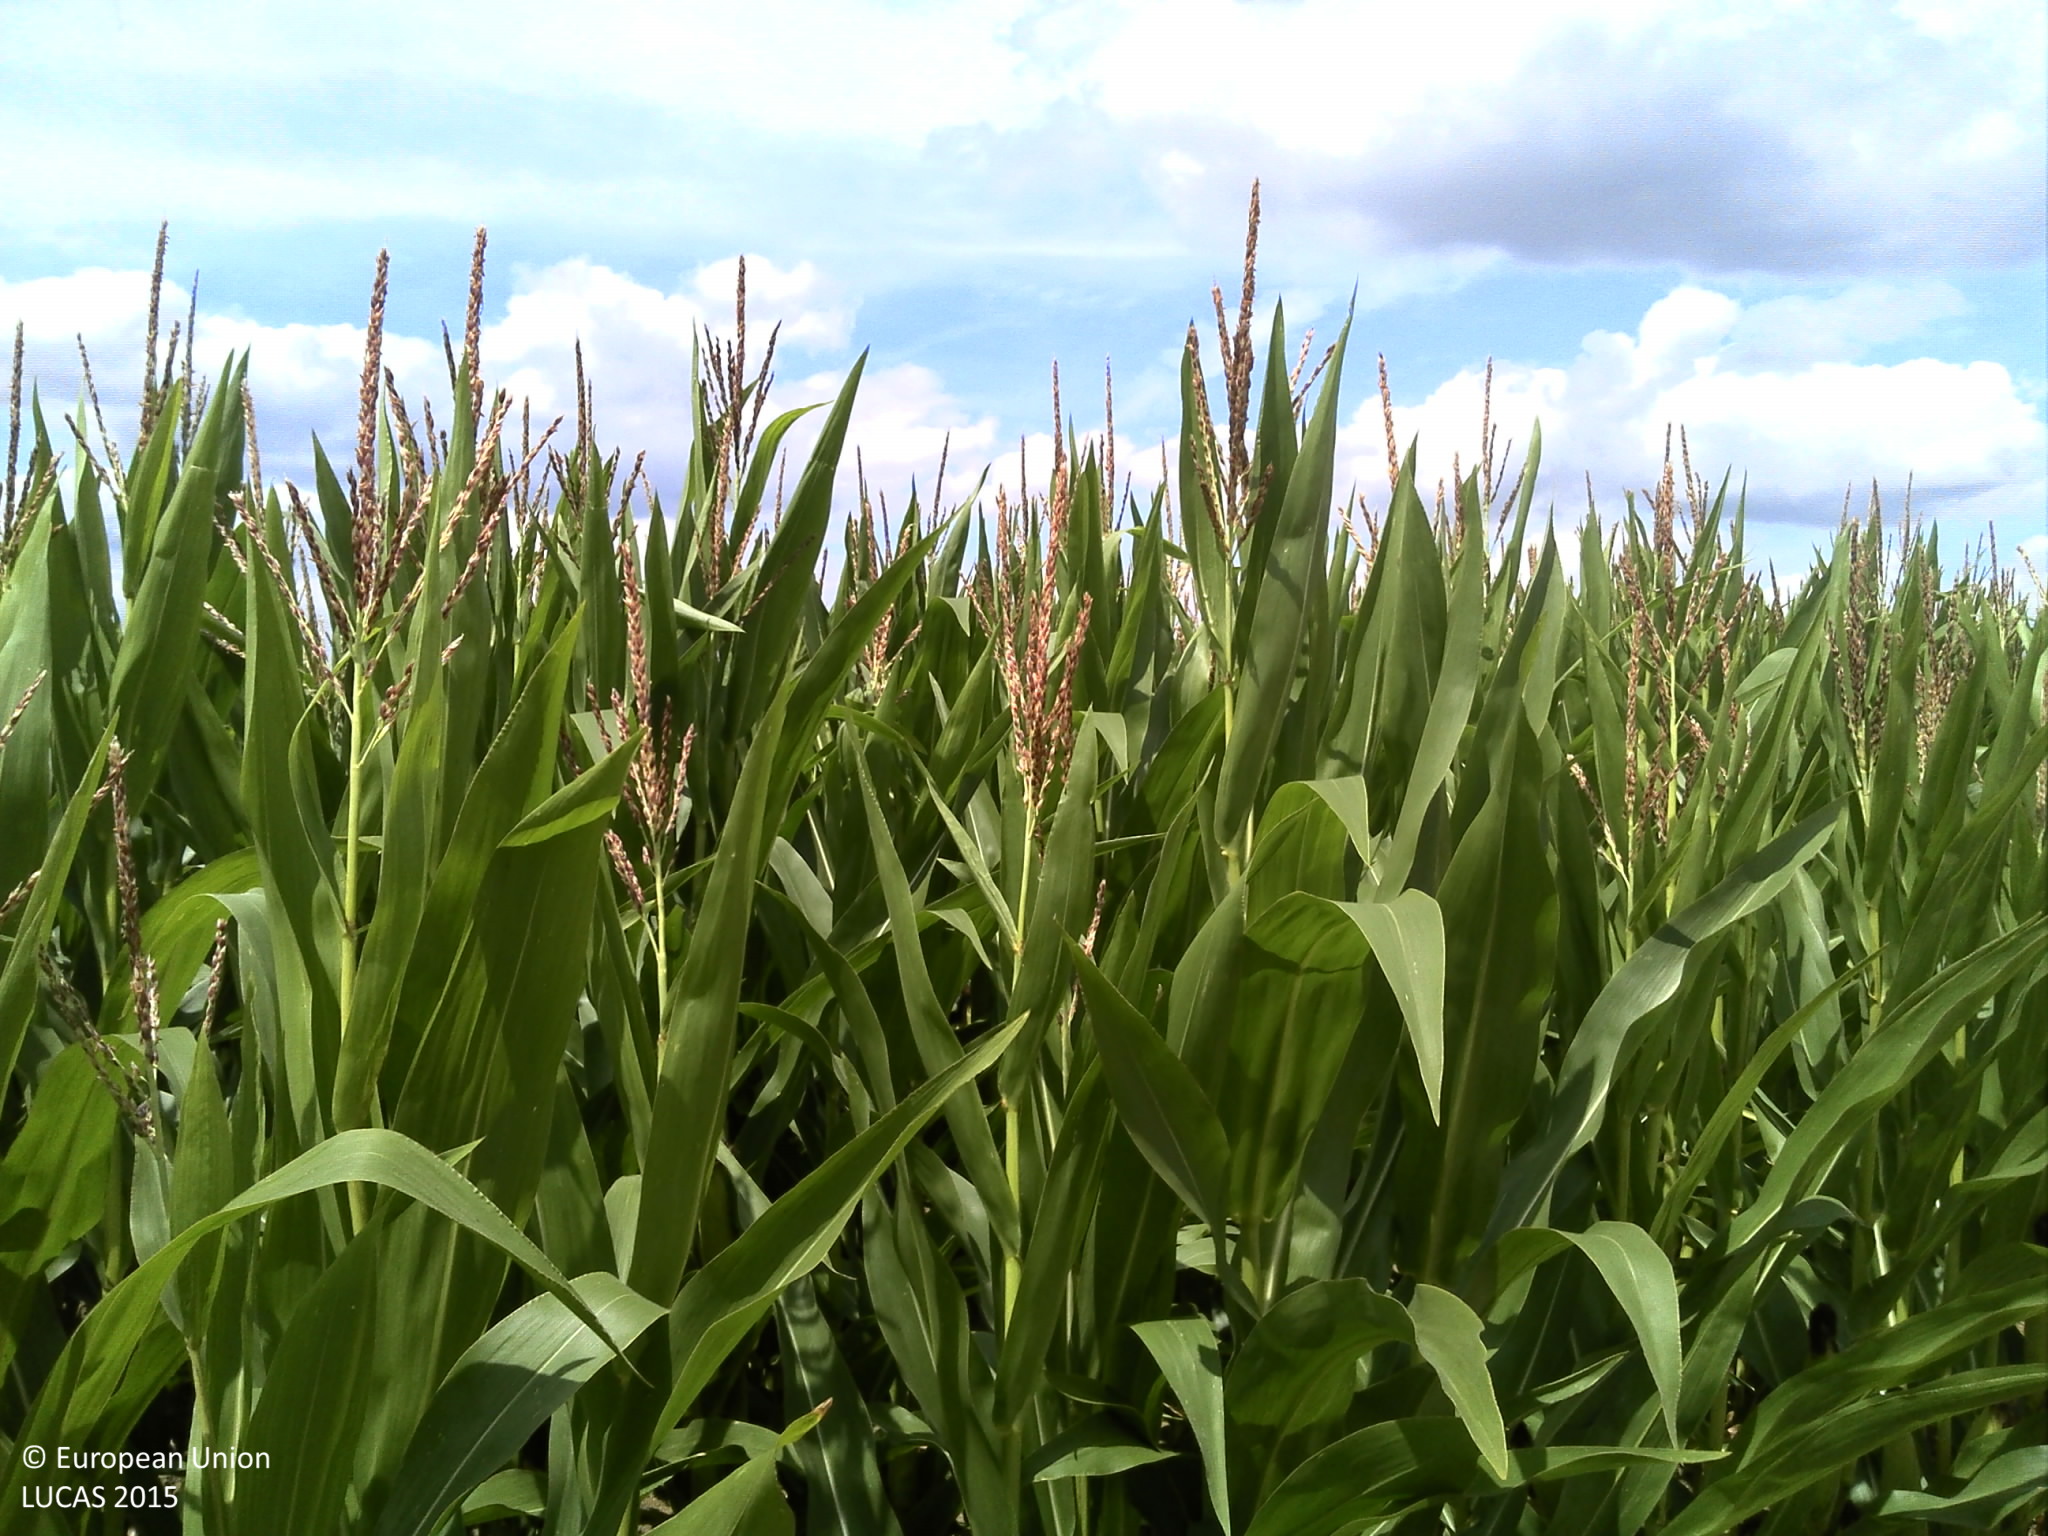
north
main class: Cropland
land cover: Maize
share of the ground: > 75 %
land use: Agriculture (excluding fallow land and kitchen gardens)
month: July
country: FR
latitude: 49.5831
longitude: 4.5051
